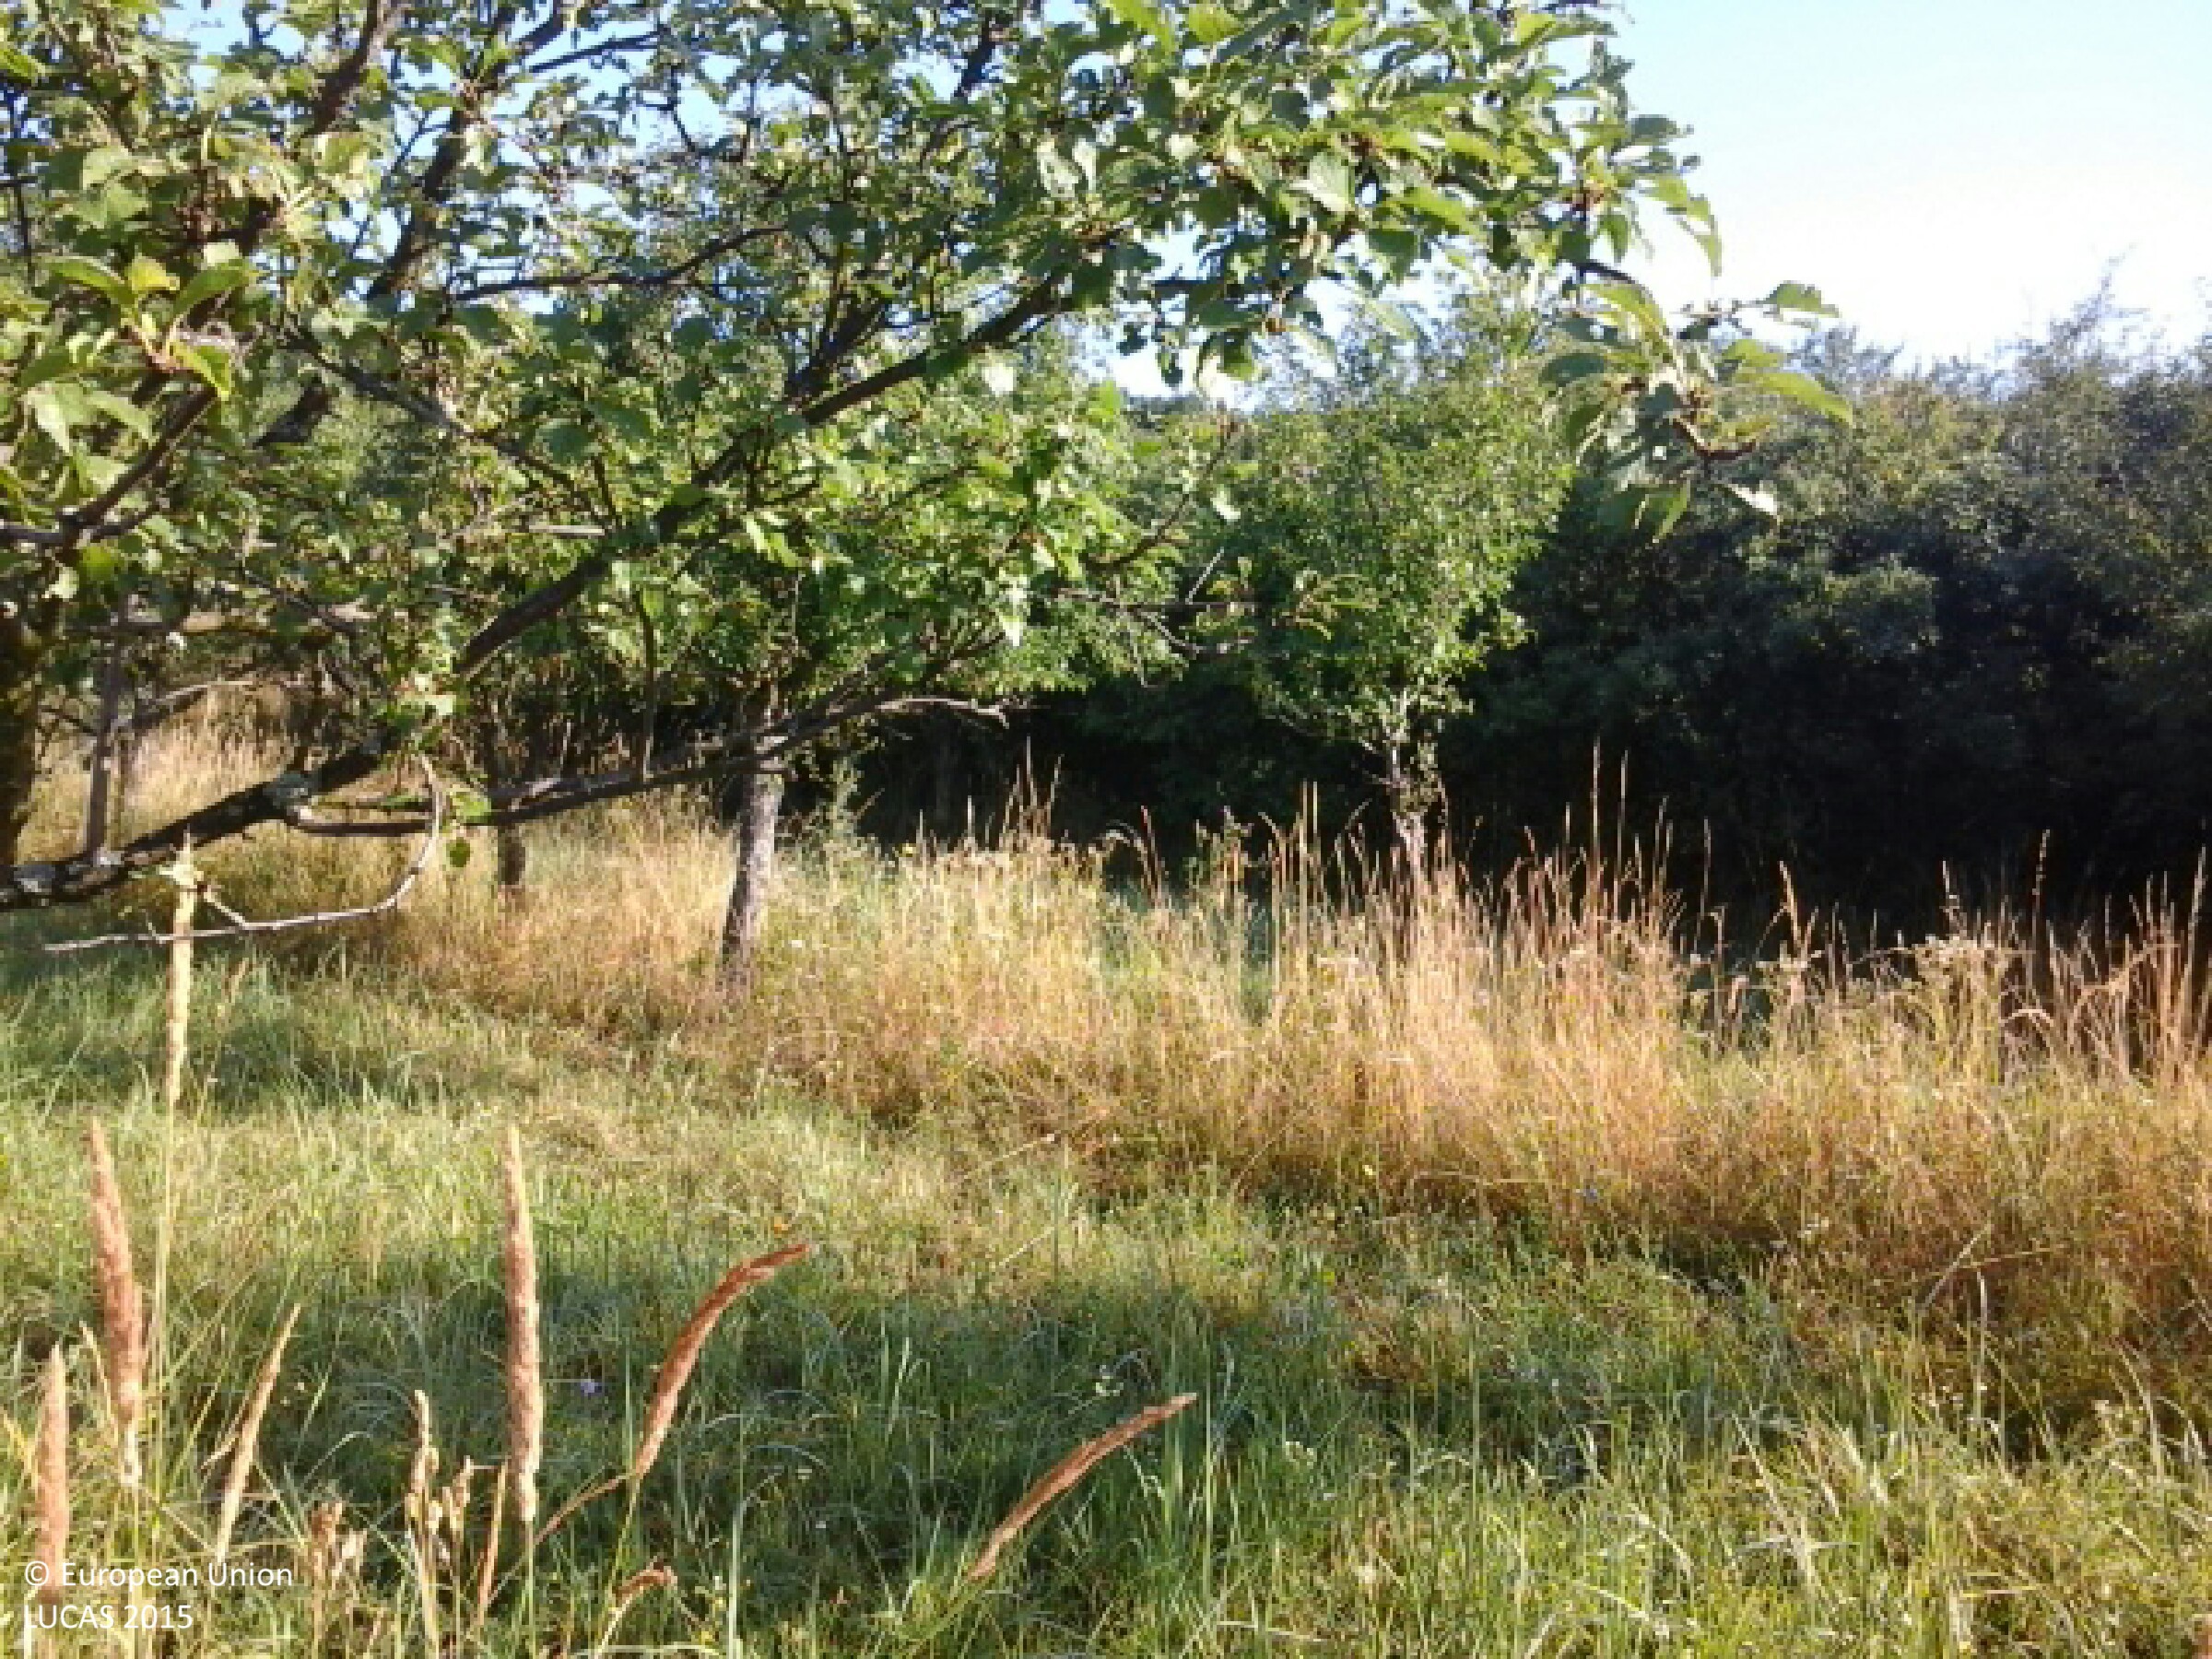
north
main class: Cropland
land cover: Other fruit trees and berries
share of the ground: 10 - 25 %
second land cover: Grassland without tree/shrub cover
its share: > 75 %
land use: Agriculture (excluding fallow land and kitchen gardens)
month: July
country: HU
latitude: 48.3584
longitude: 21.5596
